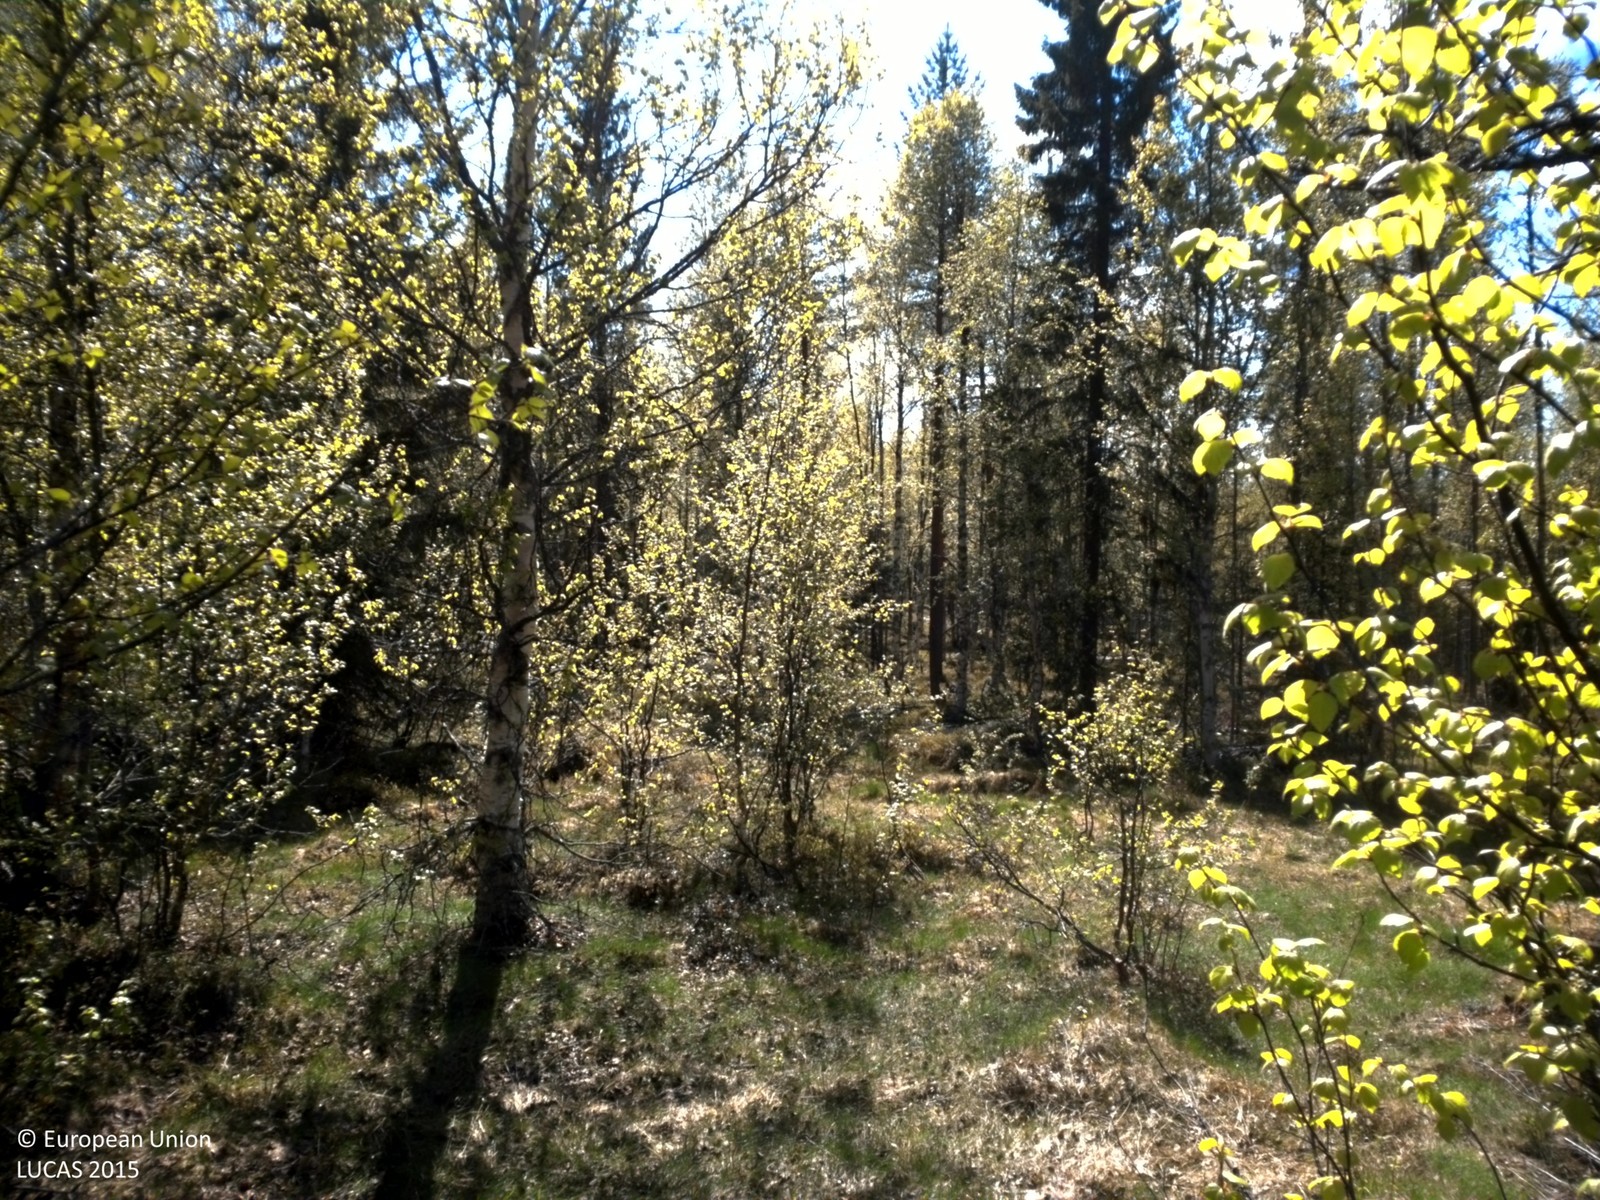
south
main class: Woodland
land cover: Pine dominated mixed woodland
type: boreal forest
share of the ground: 25 - 50 %
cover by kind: coniferous forest trees 30 %, herbaceous plants 30 %, broadleaved forest trees 20 %, shrubs 10 %, lichens and mosses 10 %
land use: Forestry
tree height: > 5 m
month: June
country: SE
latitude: 64.3543
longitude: 17.3611
